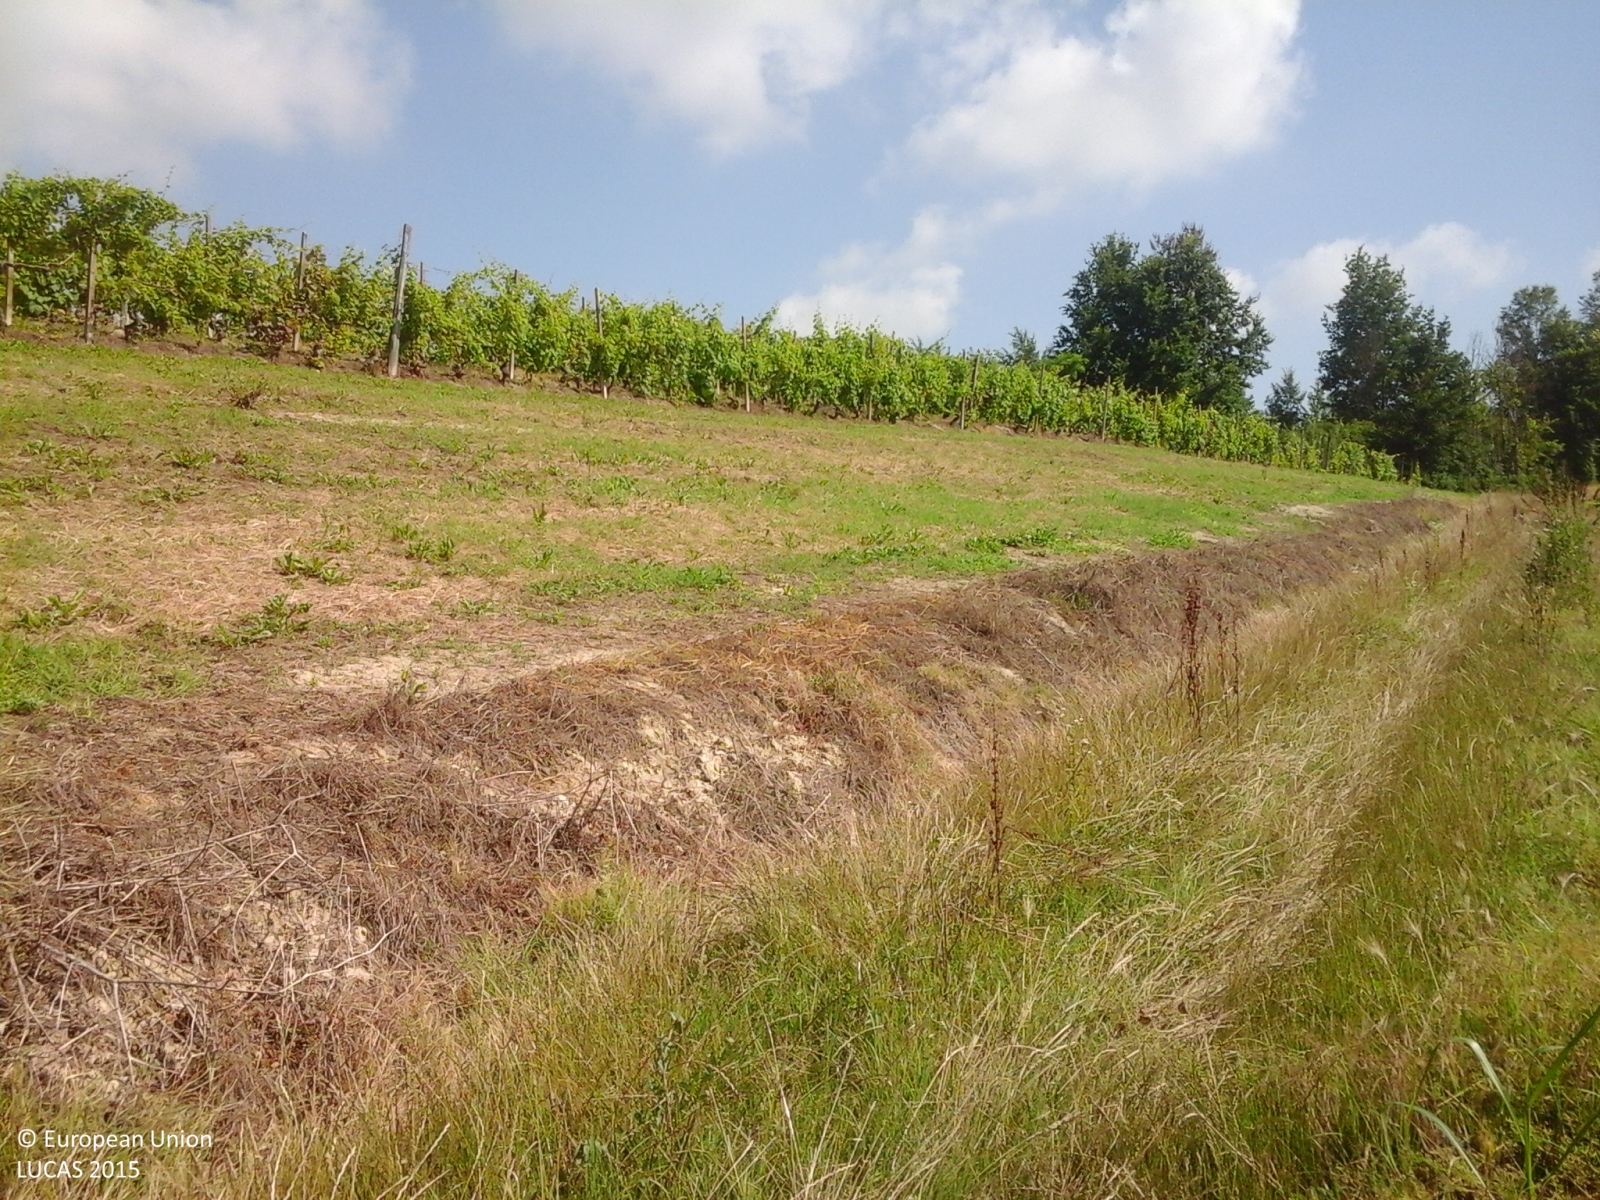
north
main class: Cropland
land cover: Dry pulses
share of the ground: > 75 %
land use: Agriculture (excluding fallow land and kitchen gardens)
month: June
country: IT
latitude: 44.9682
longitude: 8.3169
